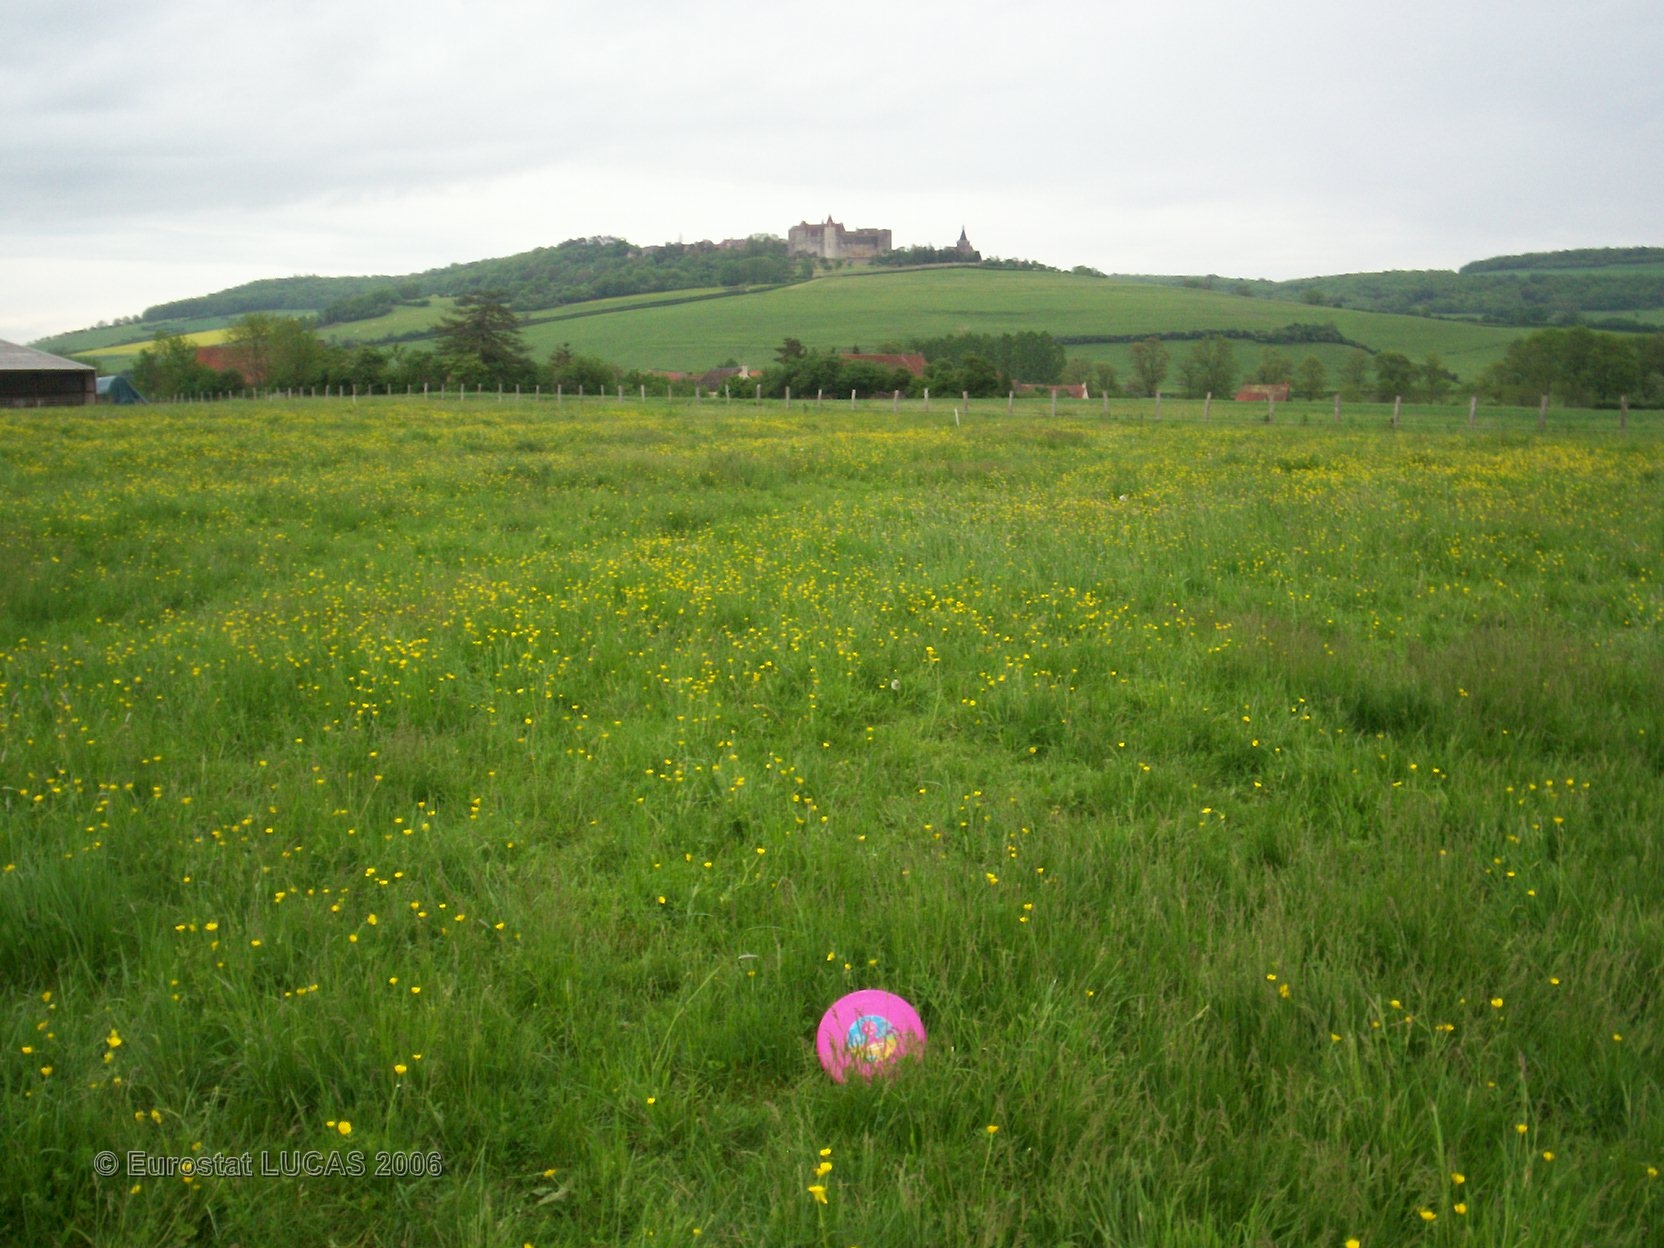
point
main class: Grassland
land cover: Grassland without tree/shrub cover
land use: Agriculture (excluding fallow land and kitchen gardens)
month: May
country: FR
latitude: 47.2087
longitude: 4.6265
